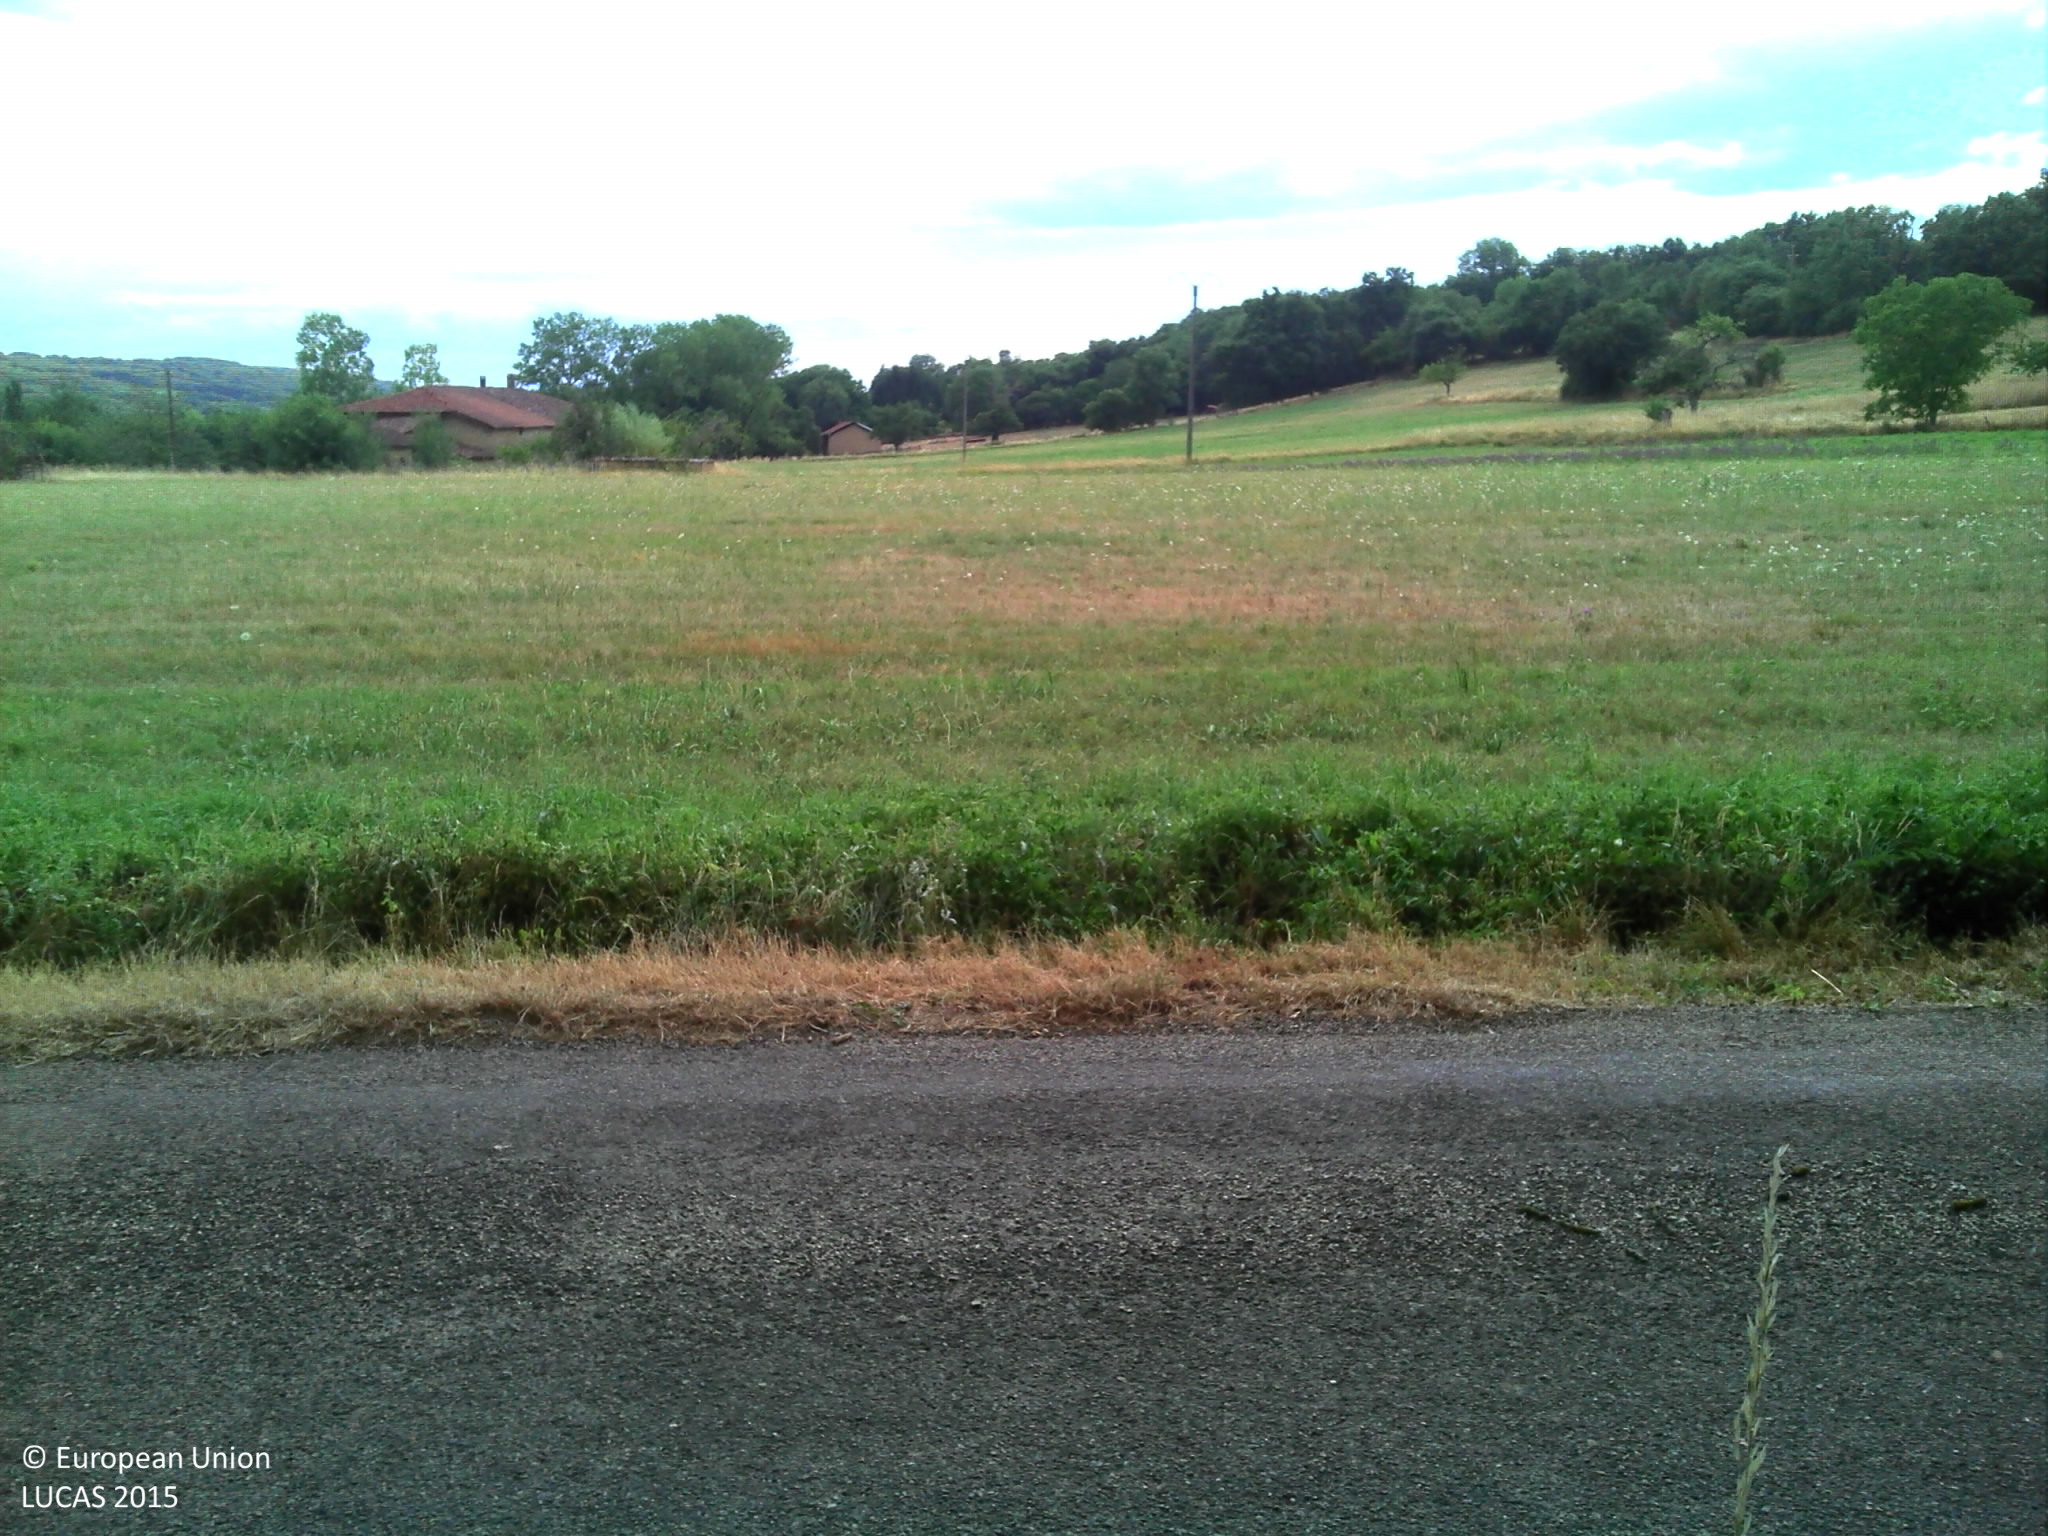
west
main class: Woodland
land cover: Broadleaved woodland
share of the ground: > 75 %
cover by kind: broadleaved forest trees 75 %, herbaceous plants 15 %, shrubs 10 %
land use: Semi-natural and natural areas not in use
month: July
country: FR
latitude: 45.4092
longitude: 5.1110
